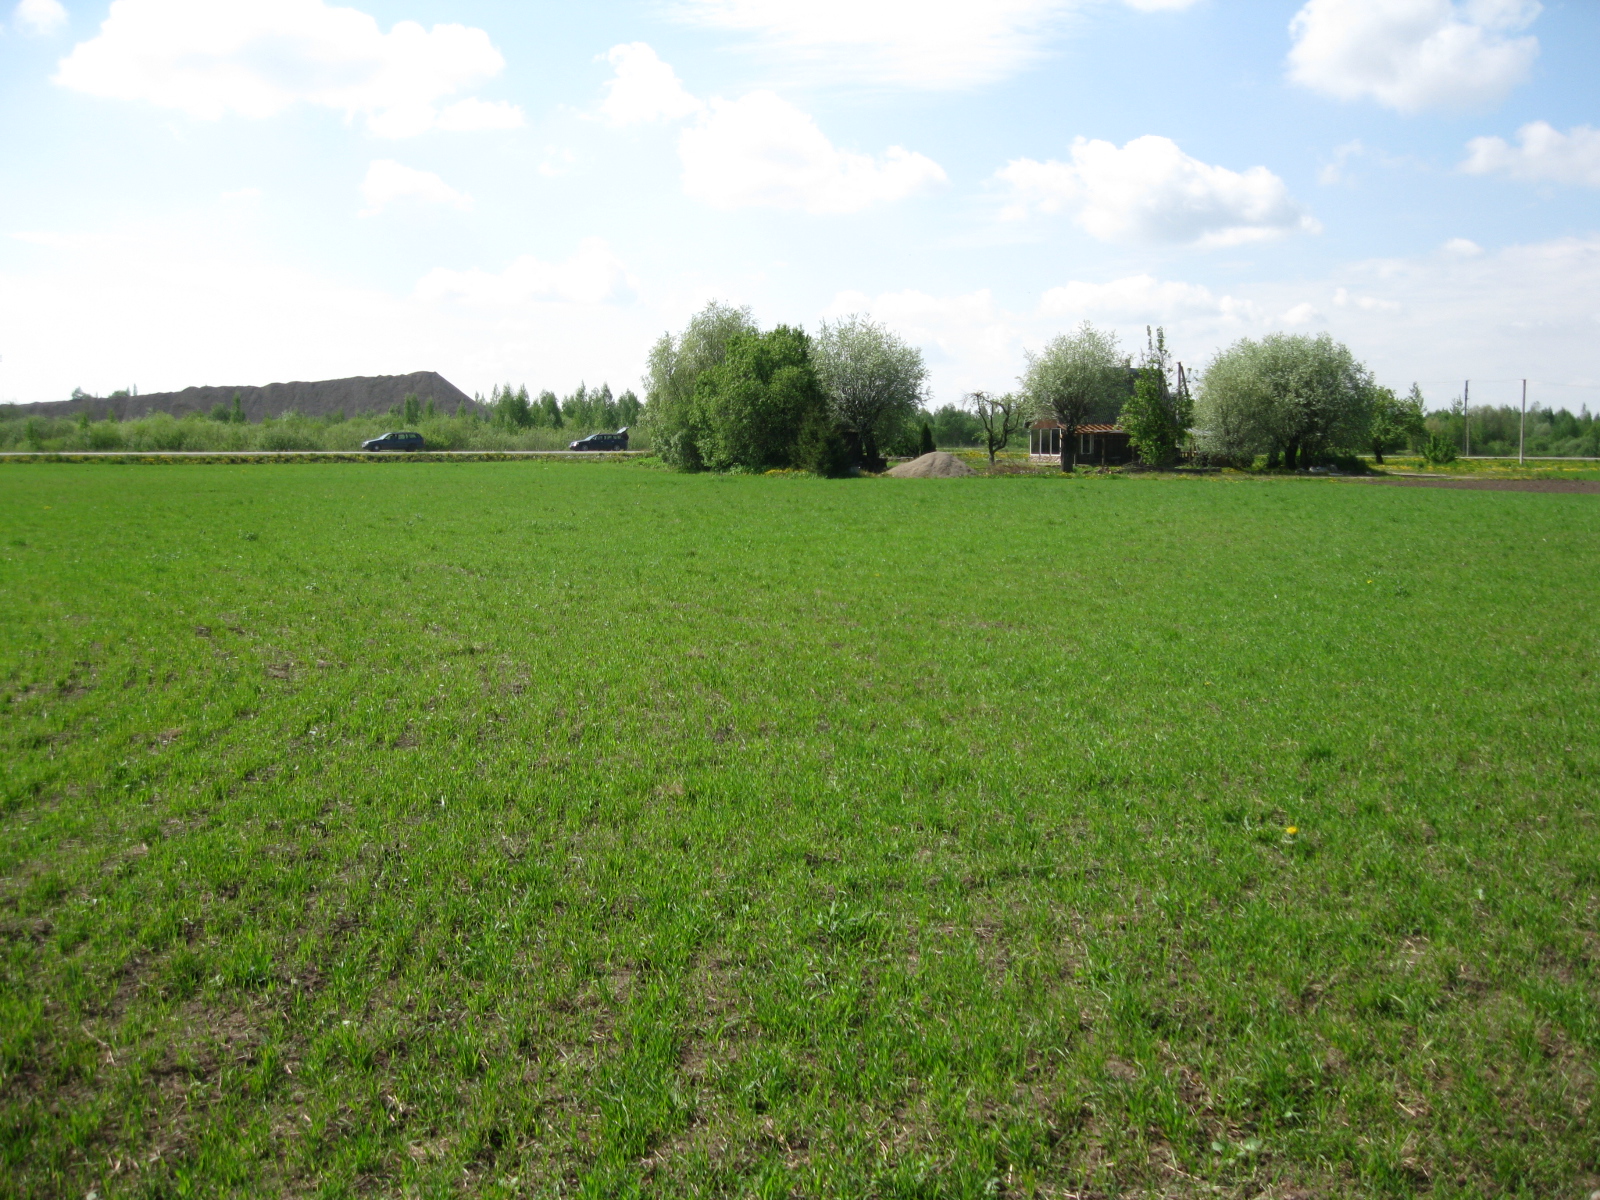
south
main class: Cropland
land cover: Common wheat
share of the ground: > 75 %
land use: Agriculture (excluding fallow land and kitchen gardens)
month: May
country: LT
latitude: 56.0257
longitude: 23.9329
